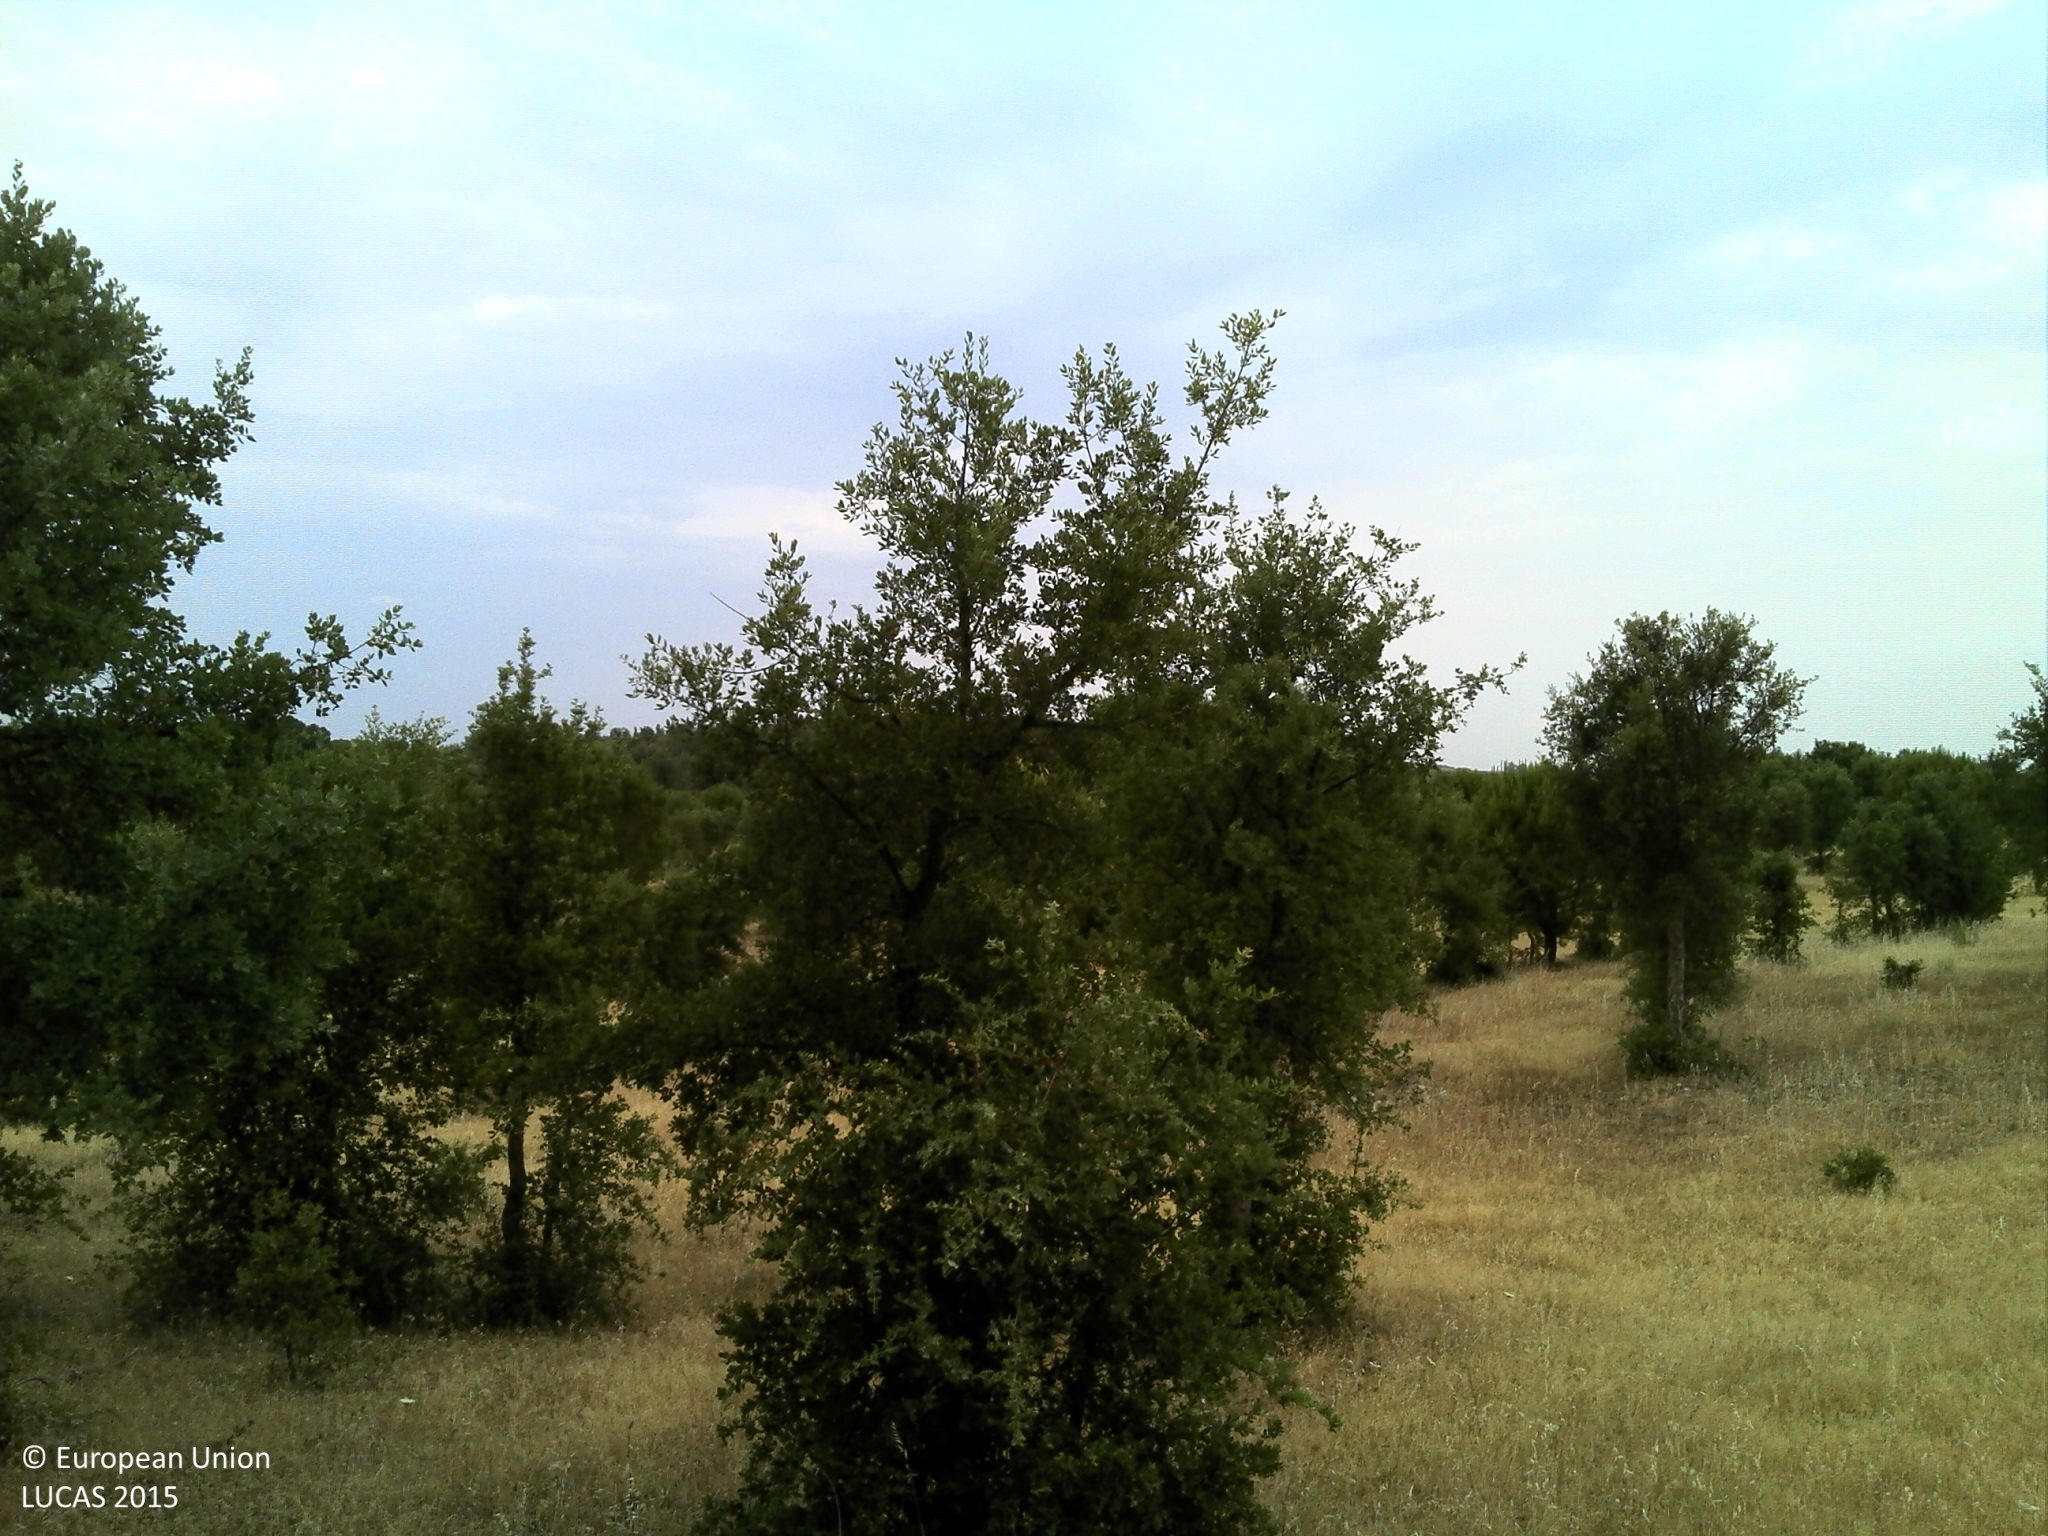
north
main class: Woodland
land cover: Broadleaved woodland
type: broadleaved evergreen forest
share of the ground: 25 - 50 %
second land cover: Grassland without tree/shrub cover
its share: 25 - 50 %
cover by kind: unconsolidated bare surface 40 %, broadleaved forest trees 30 %, herbaceous plants 30 %
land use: Forestry
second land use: Agriculture (excluding fallow land and kitchen gardens)
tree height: < 5 m
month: June
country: PT
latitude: 38.6452
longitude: -7.7893
